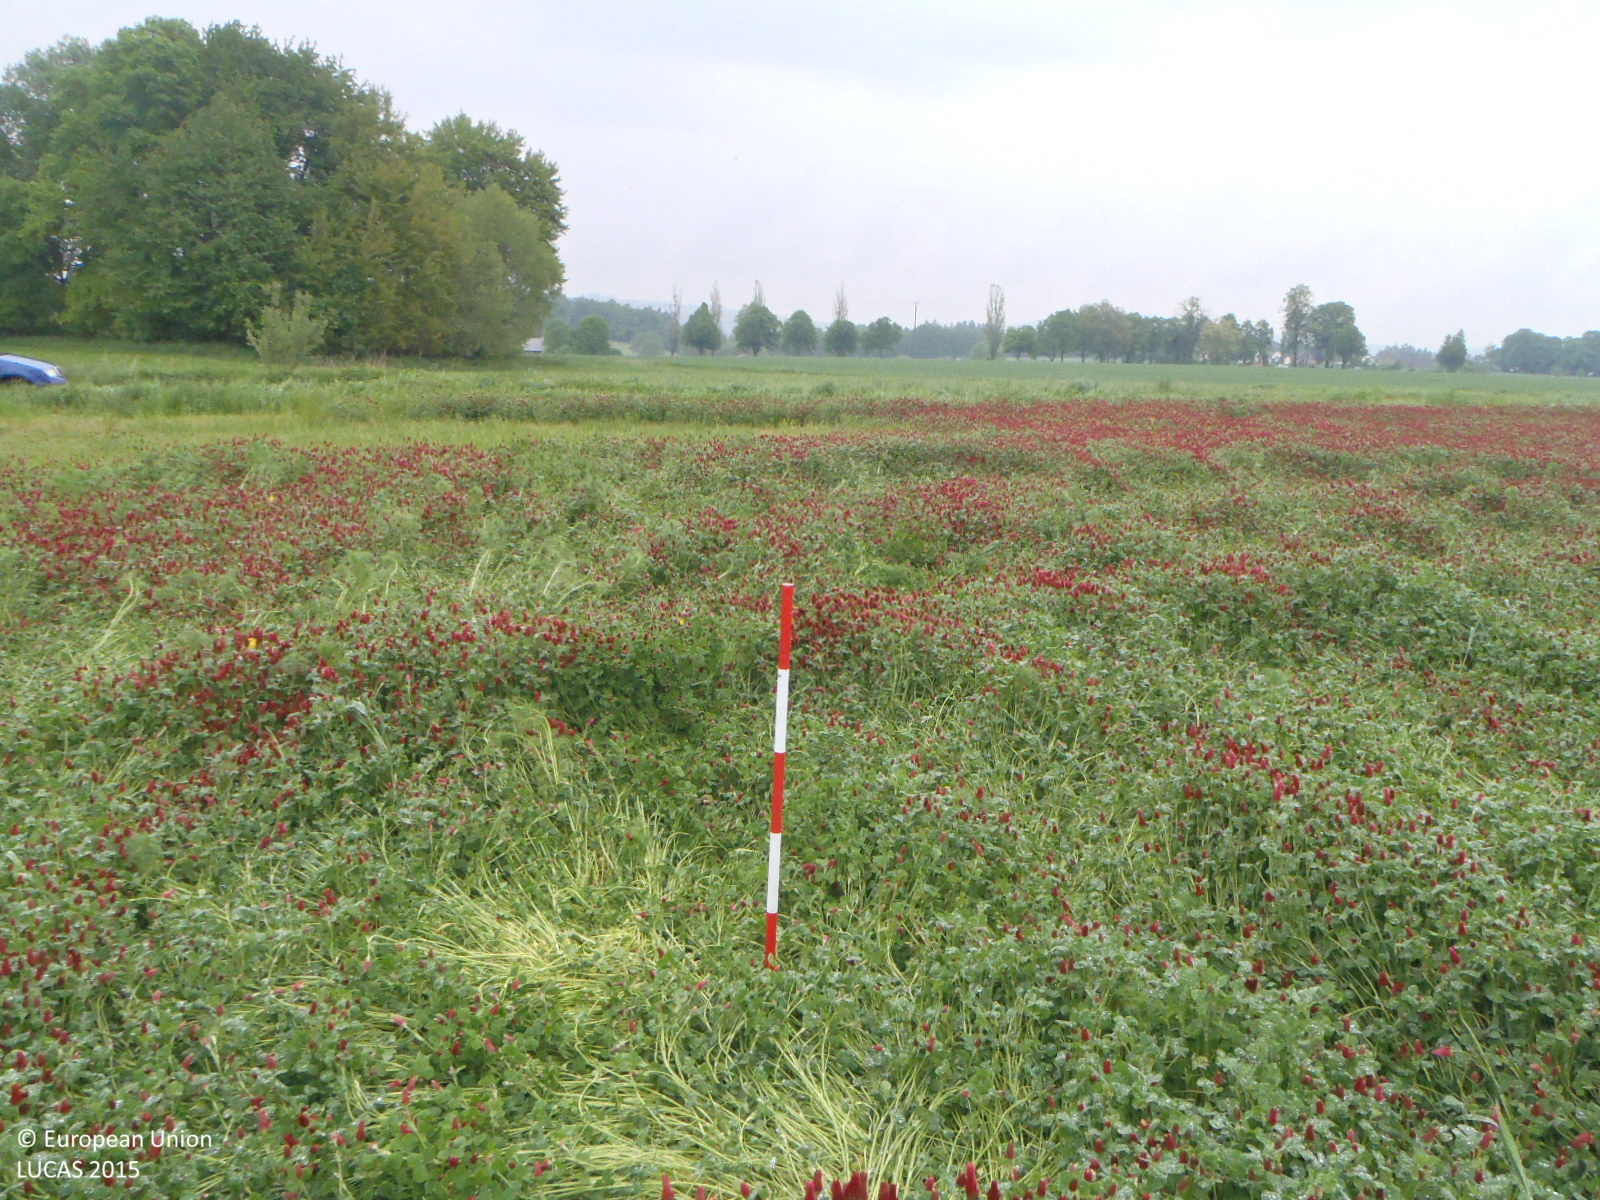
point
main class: Cropland
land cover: Clovers
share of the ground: > 75 %
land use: Agriculture (excluding fallow land and kitchen gardens)
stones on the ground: < 10 %
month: May
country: CZ
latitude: 48.8183
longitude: 14.4544
